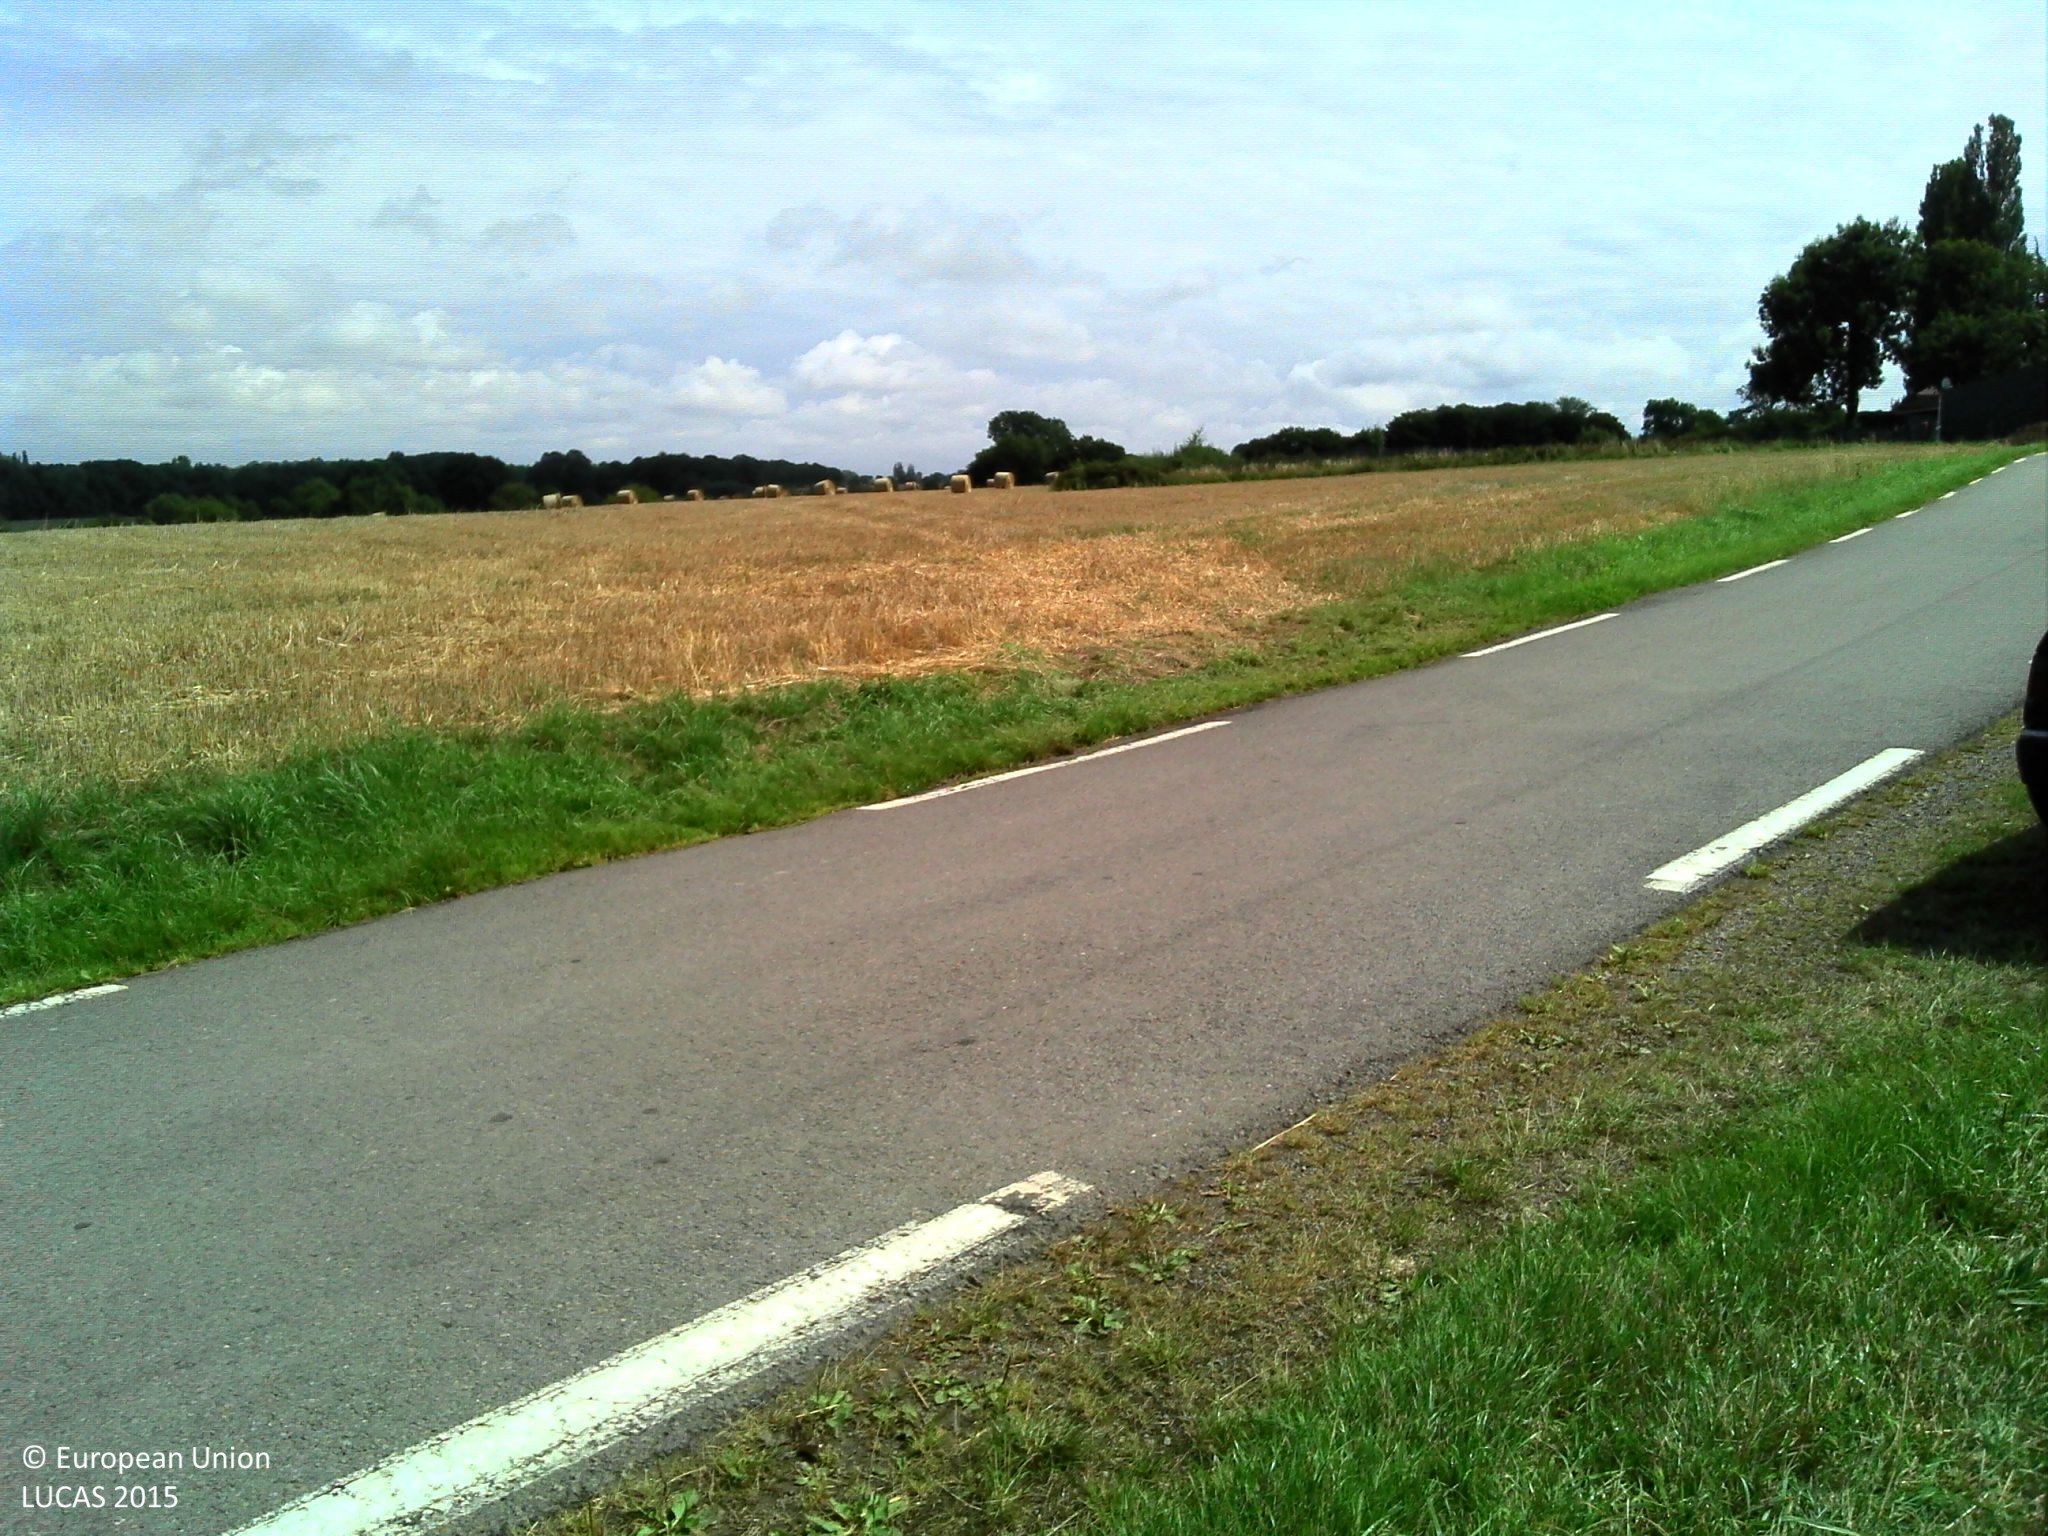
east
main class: Grassland
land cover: Grassland without tree/shrub cover
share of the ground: > 75 %
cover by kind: herbaceous plants 100 %
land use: Agriculture (excluding fallow land and kitchen gardens)
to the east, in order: Grassland without tree/shrub cover; Electric lines; Grassland without tree/shrub cover; Fences; Electric lines; Grass margins; Ditches and canals; Grass margins; Paved roads, cycling and walking lanes; Grass margins; Ditches and canals; Grass margins; Common wheat; Grass margins; Fences; Grassland without tree/shrub cover; Fences; Grass margins; Common wheat
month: August
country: FR
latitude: 50.2531
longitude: 4.2026
